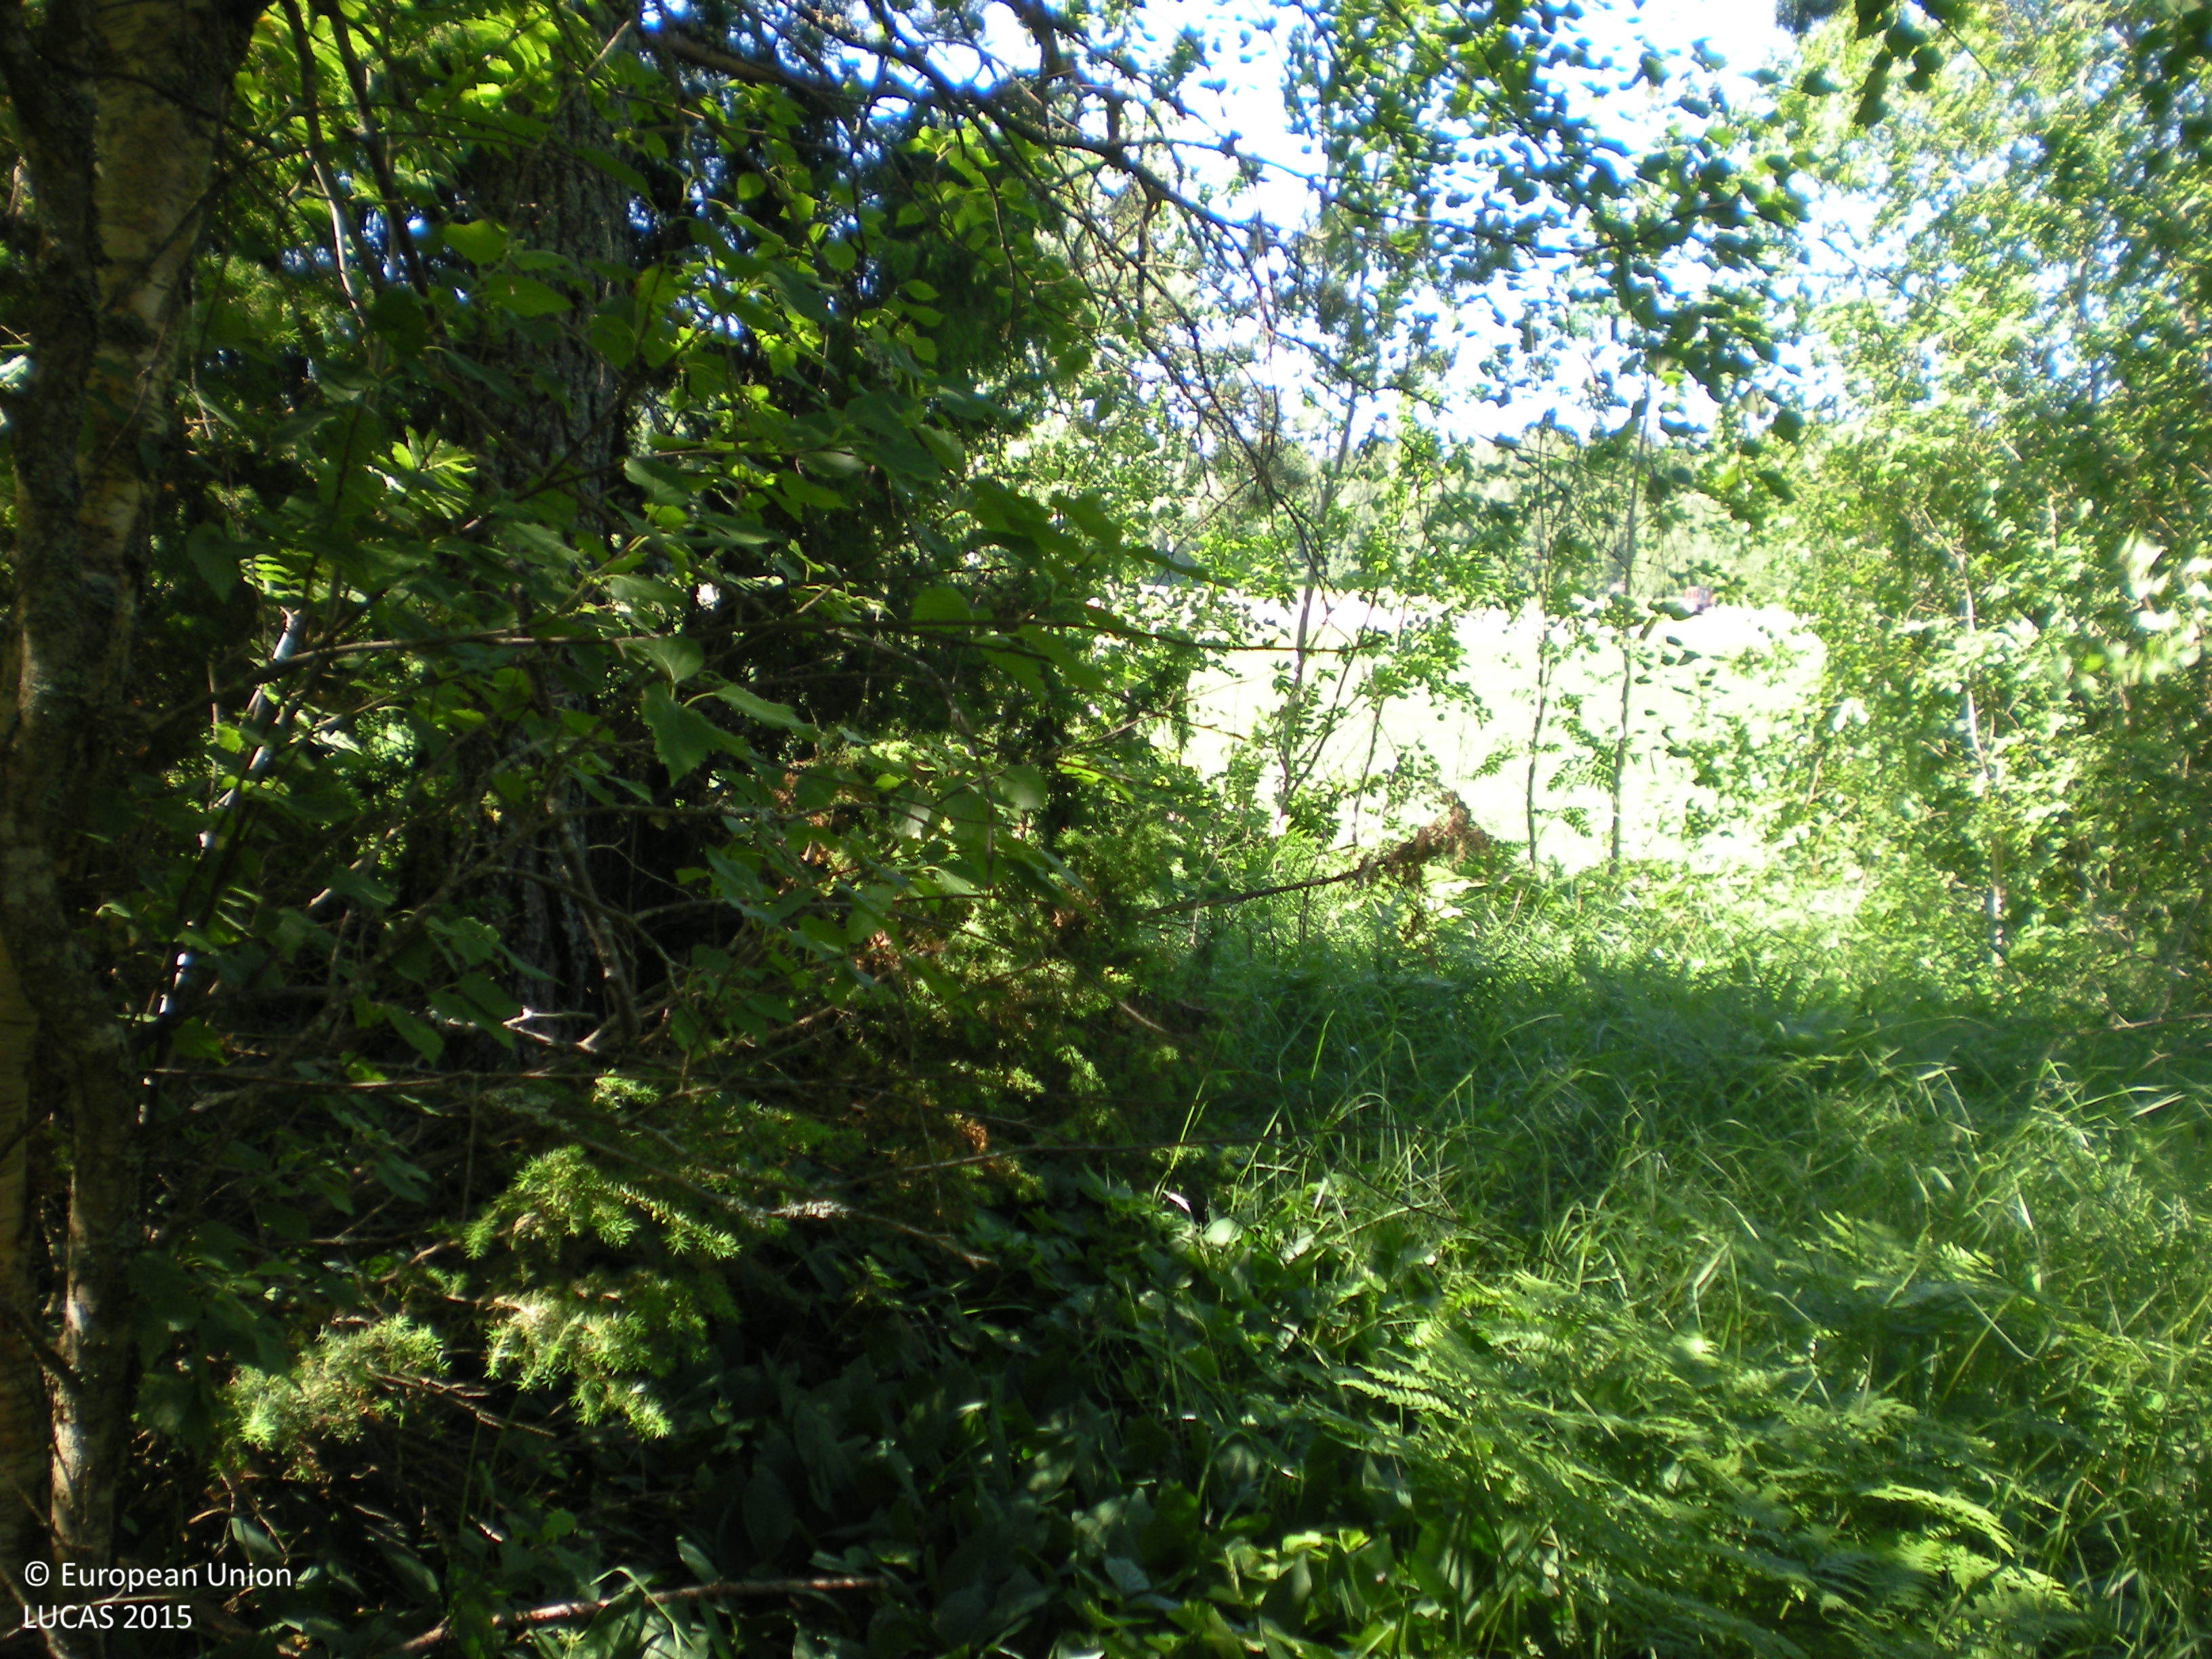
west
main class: Woodland
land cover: Broadleaved woodland
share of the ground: 50 - 75 %
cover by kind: broadleaved forest trees 45 %, herbaceous plants 40 %, shrubs 10 %, coniferous forest trees 5 %
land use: Semi-natural and natural areas not in use
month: July
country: SE
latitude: 60.4559
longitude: 17.7552
